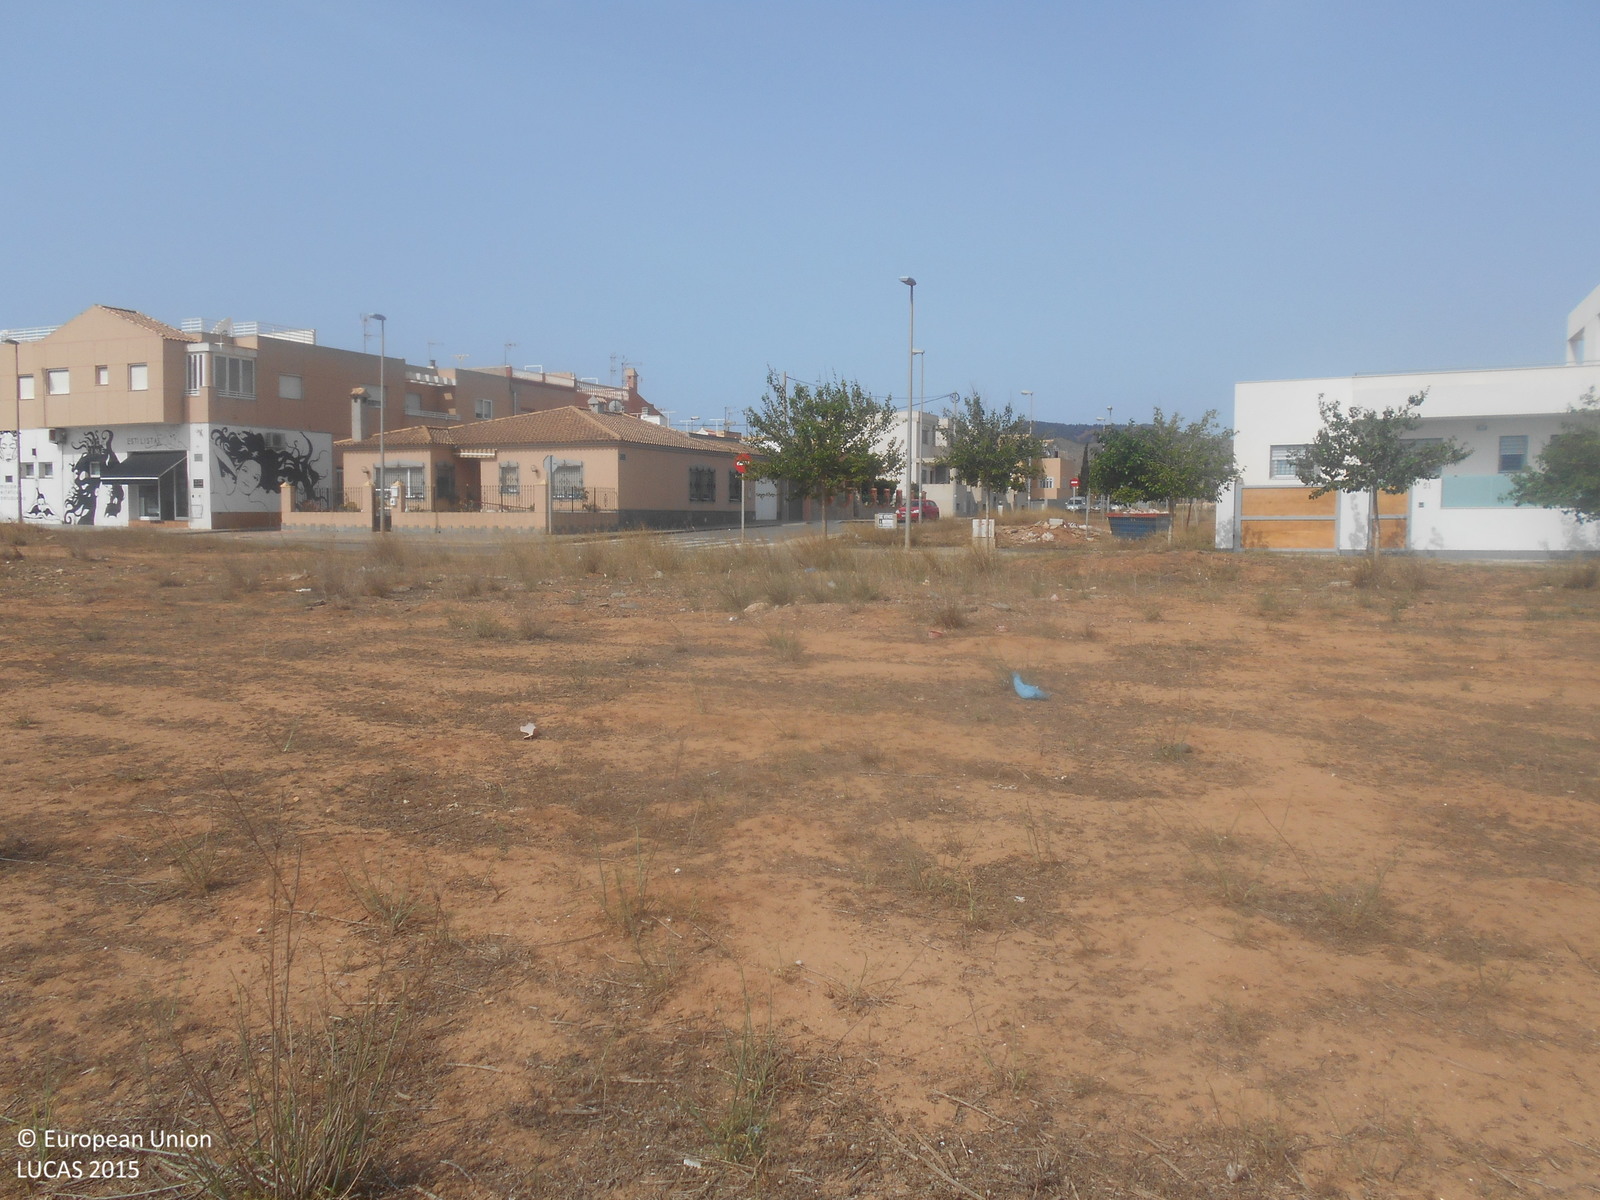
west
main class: Shrubland
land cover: Shrubland without tree cover
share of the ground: 10 - 25 %
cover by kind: unconsolidated bare surface 80 %, shrubs 10 %, herbaceous plants 10 %
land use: Semi-natural and natural areas not in use
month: May
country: ES
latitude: 37.6269
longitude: -0.7762
